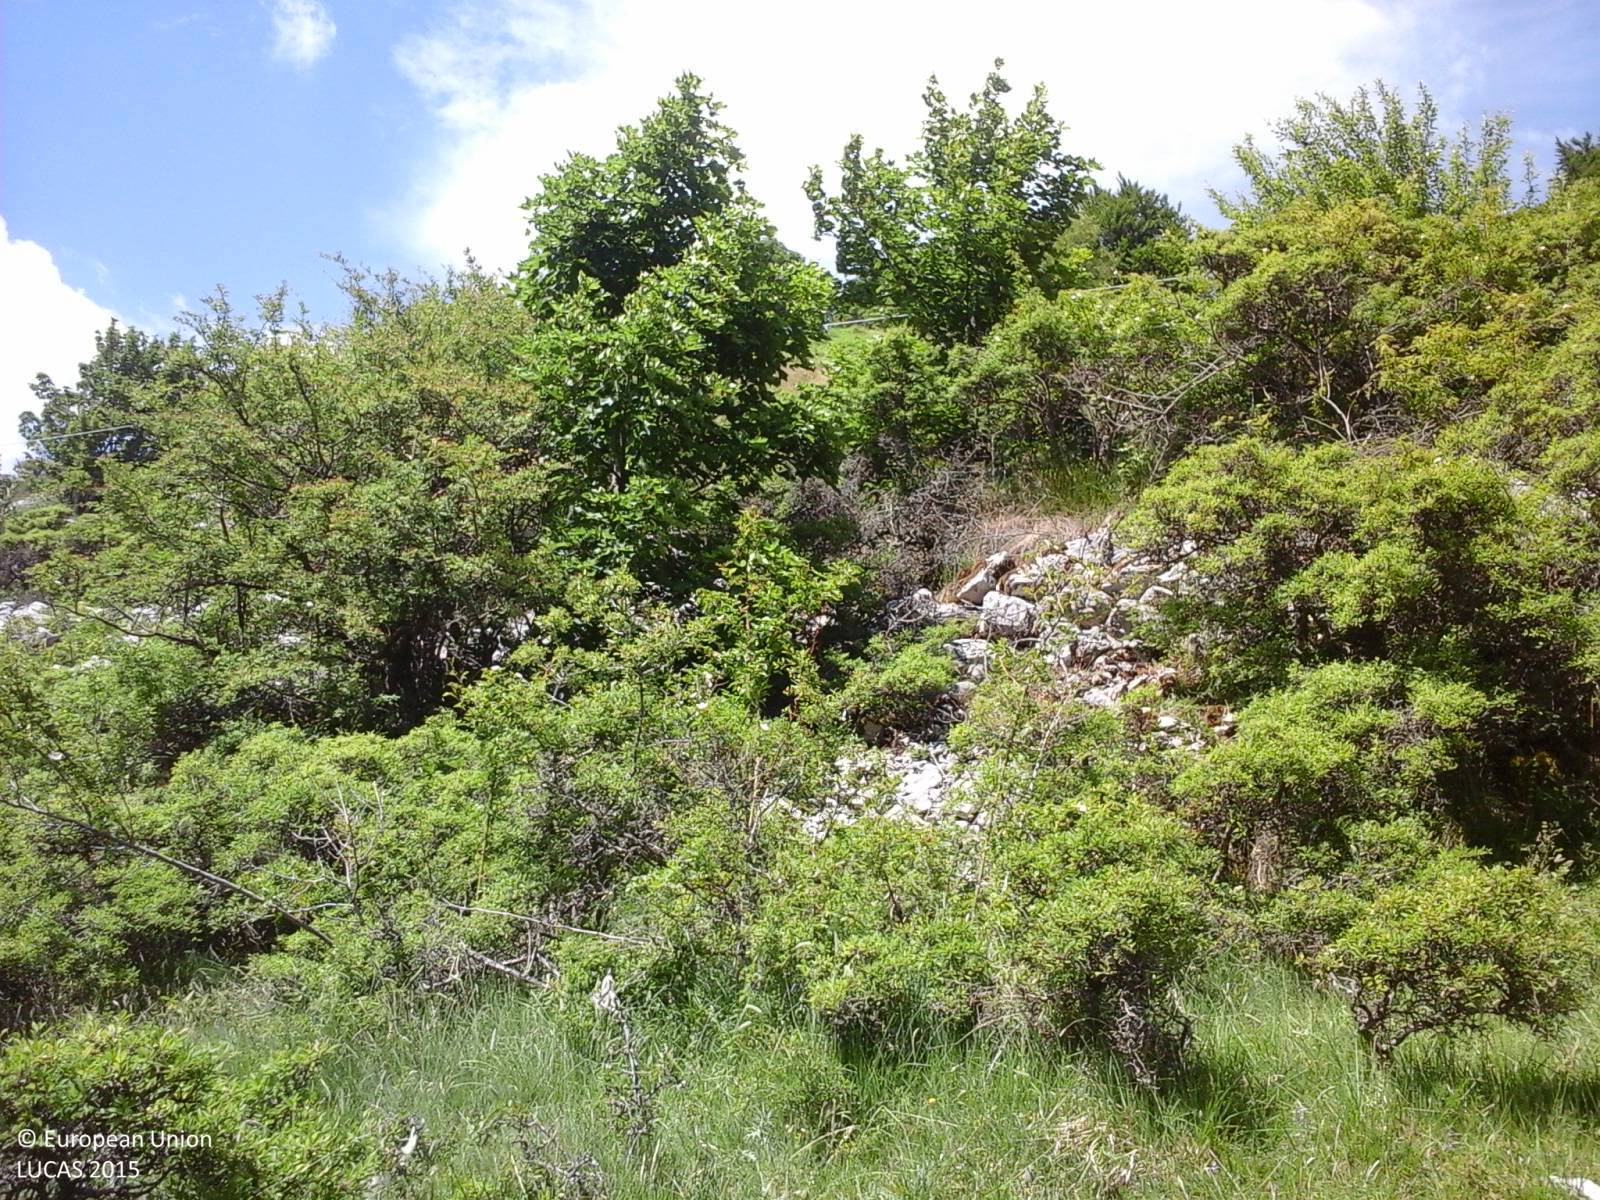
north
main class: Shrubland
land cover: Shrubland with sparse tree cover
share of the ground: > 75 %
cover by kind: herbaceous plants 50 %, shrubs 40 %, broadleaved forest trees 5 %, unconsolidated bare surface 5 %
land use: Agriculture (excluding fallow land and kitchen gardens)
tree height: < 5 m
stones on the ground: 10 - 25 %
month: June
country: IT
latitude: 42.2537
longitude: 13.3948
